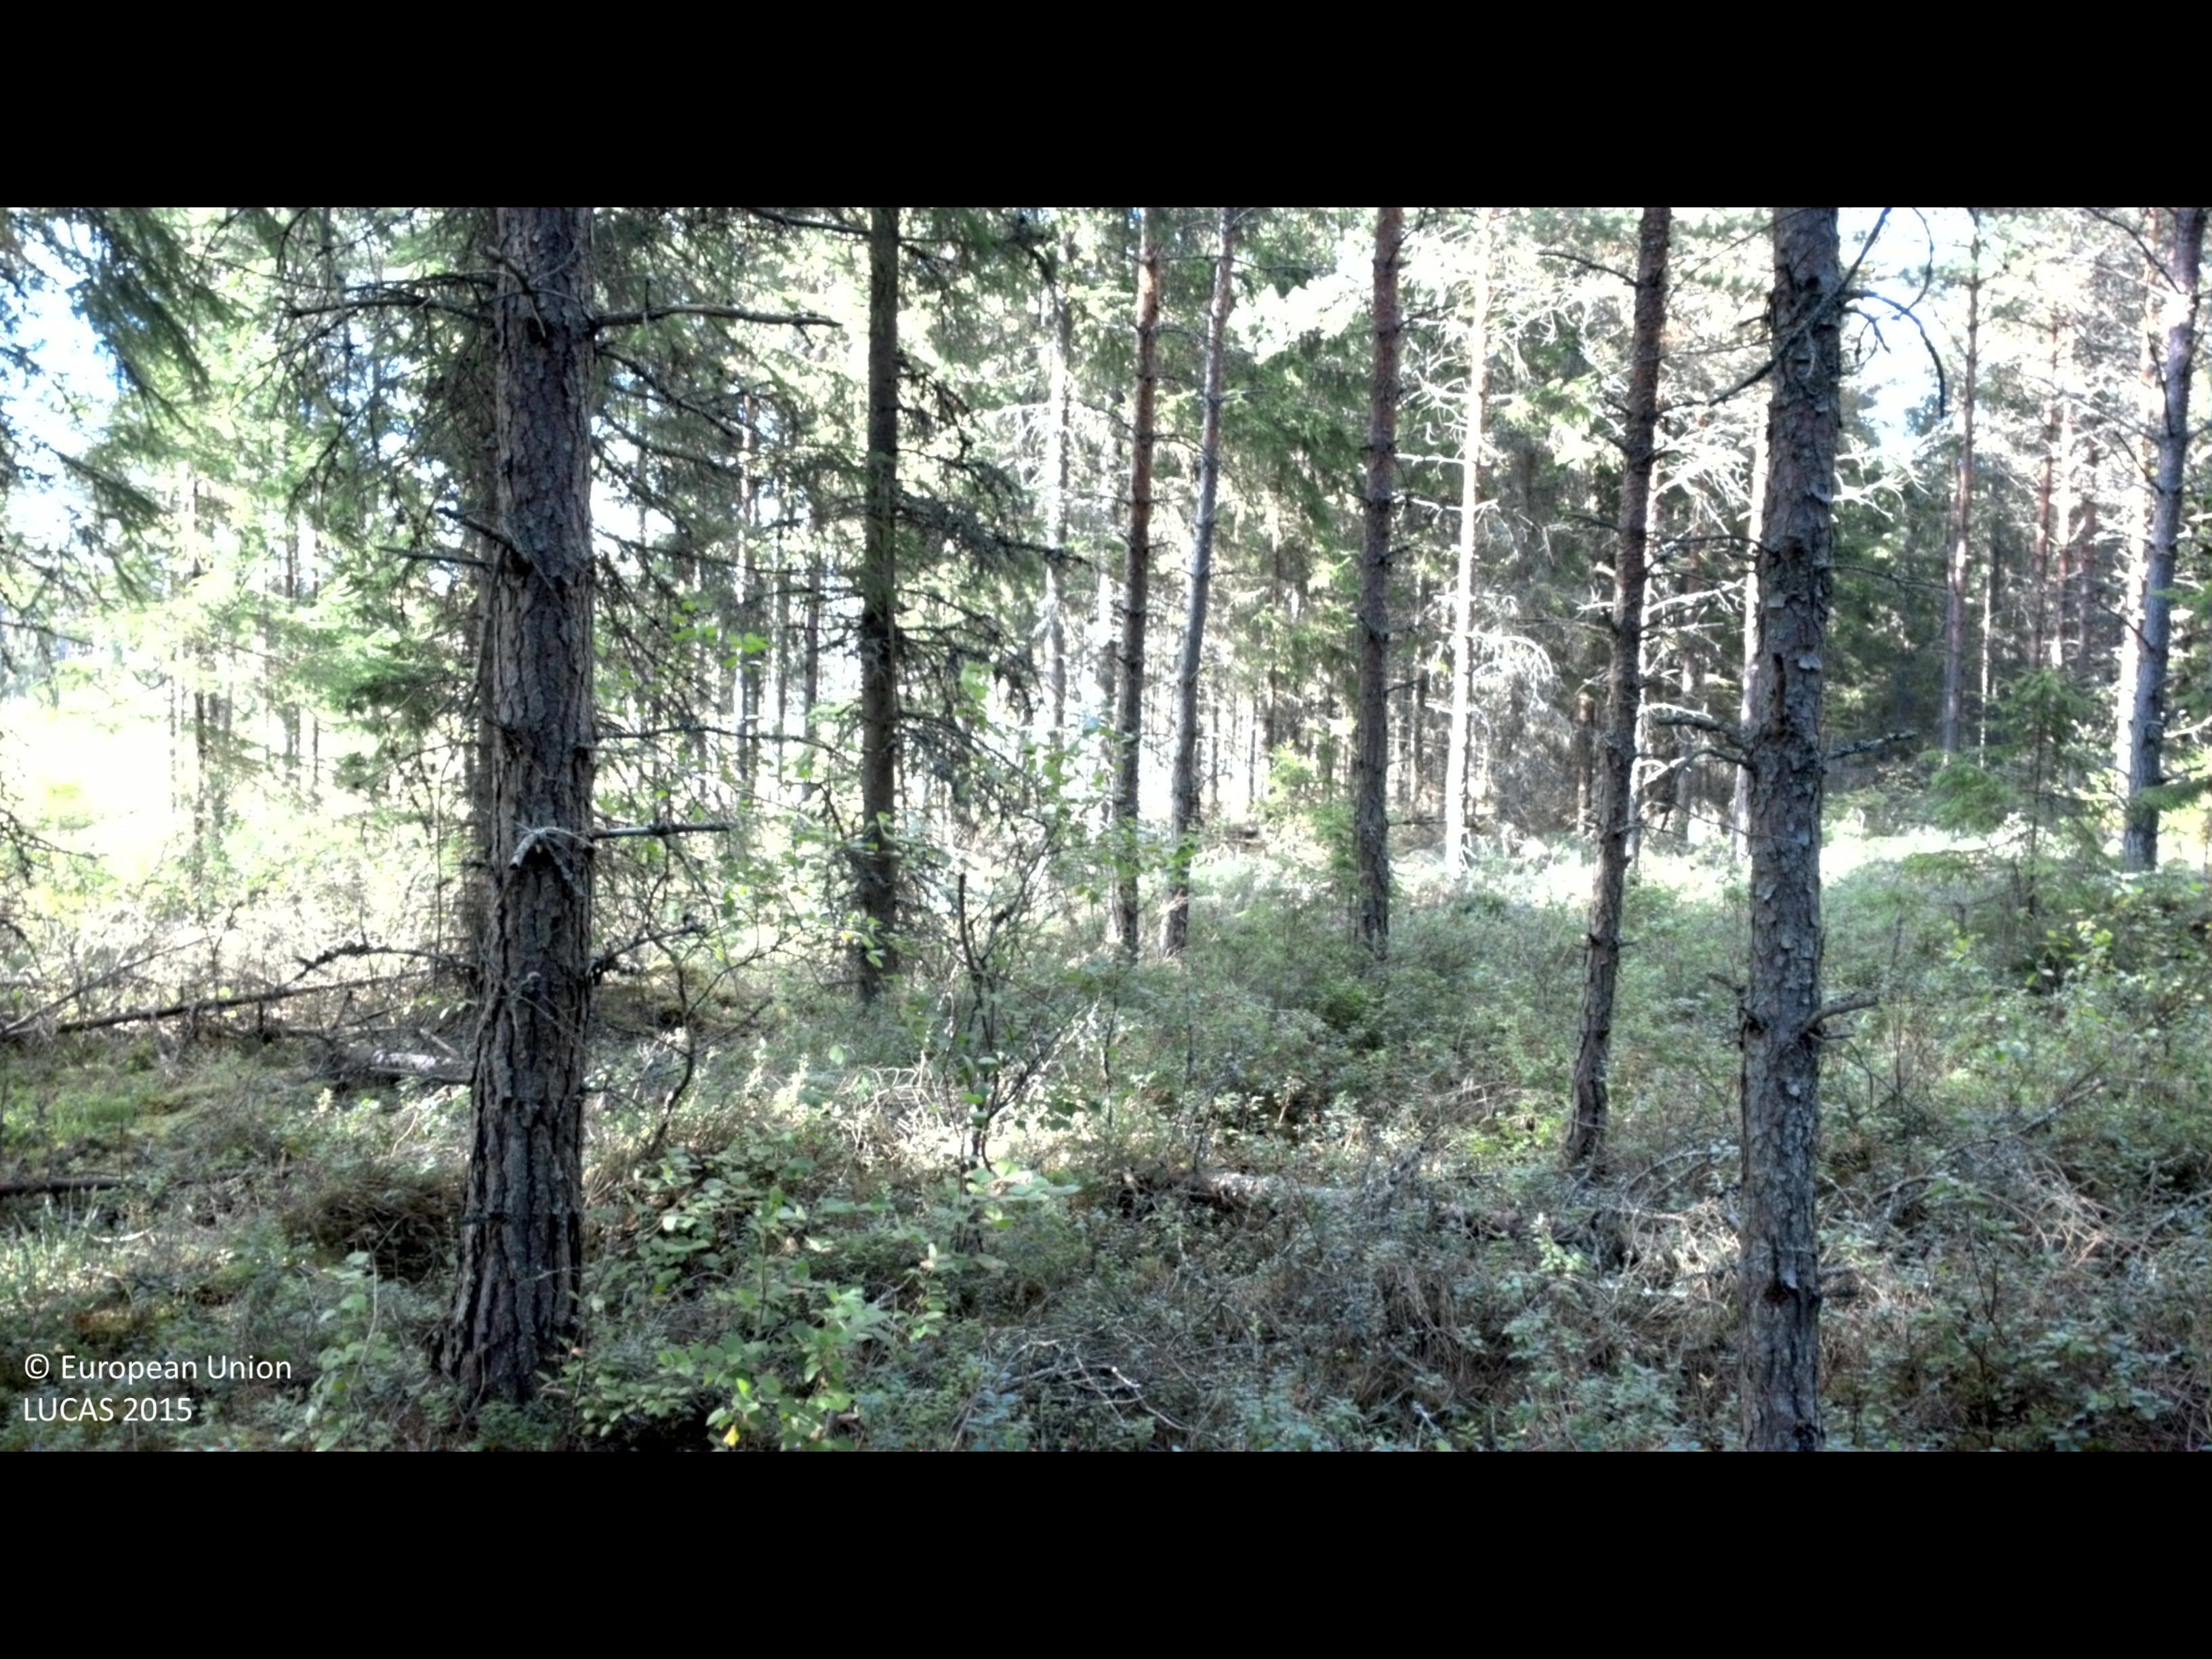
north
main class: Woodland
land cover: Pine dominated coniferous woodland
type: boreal forest
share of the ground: > 75 %
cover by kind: coniferous forest trees 75 %, shrubs 25 %
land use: Forestry
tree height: > 5 m
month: August
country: SE
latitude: 57.2270
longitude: 13.8884
